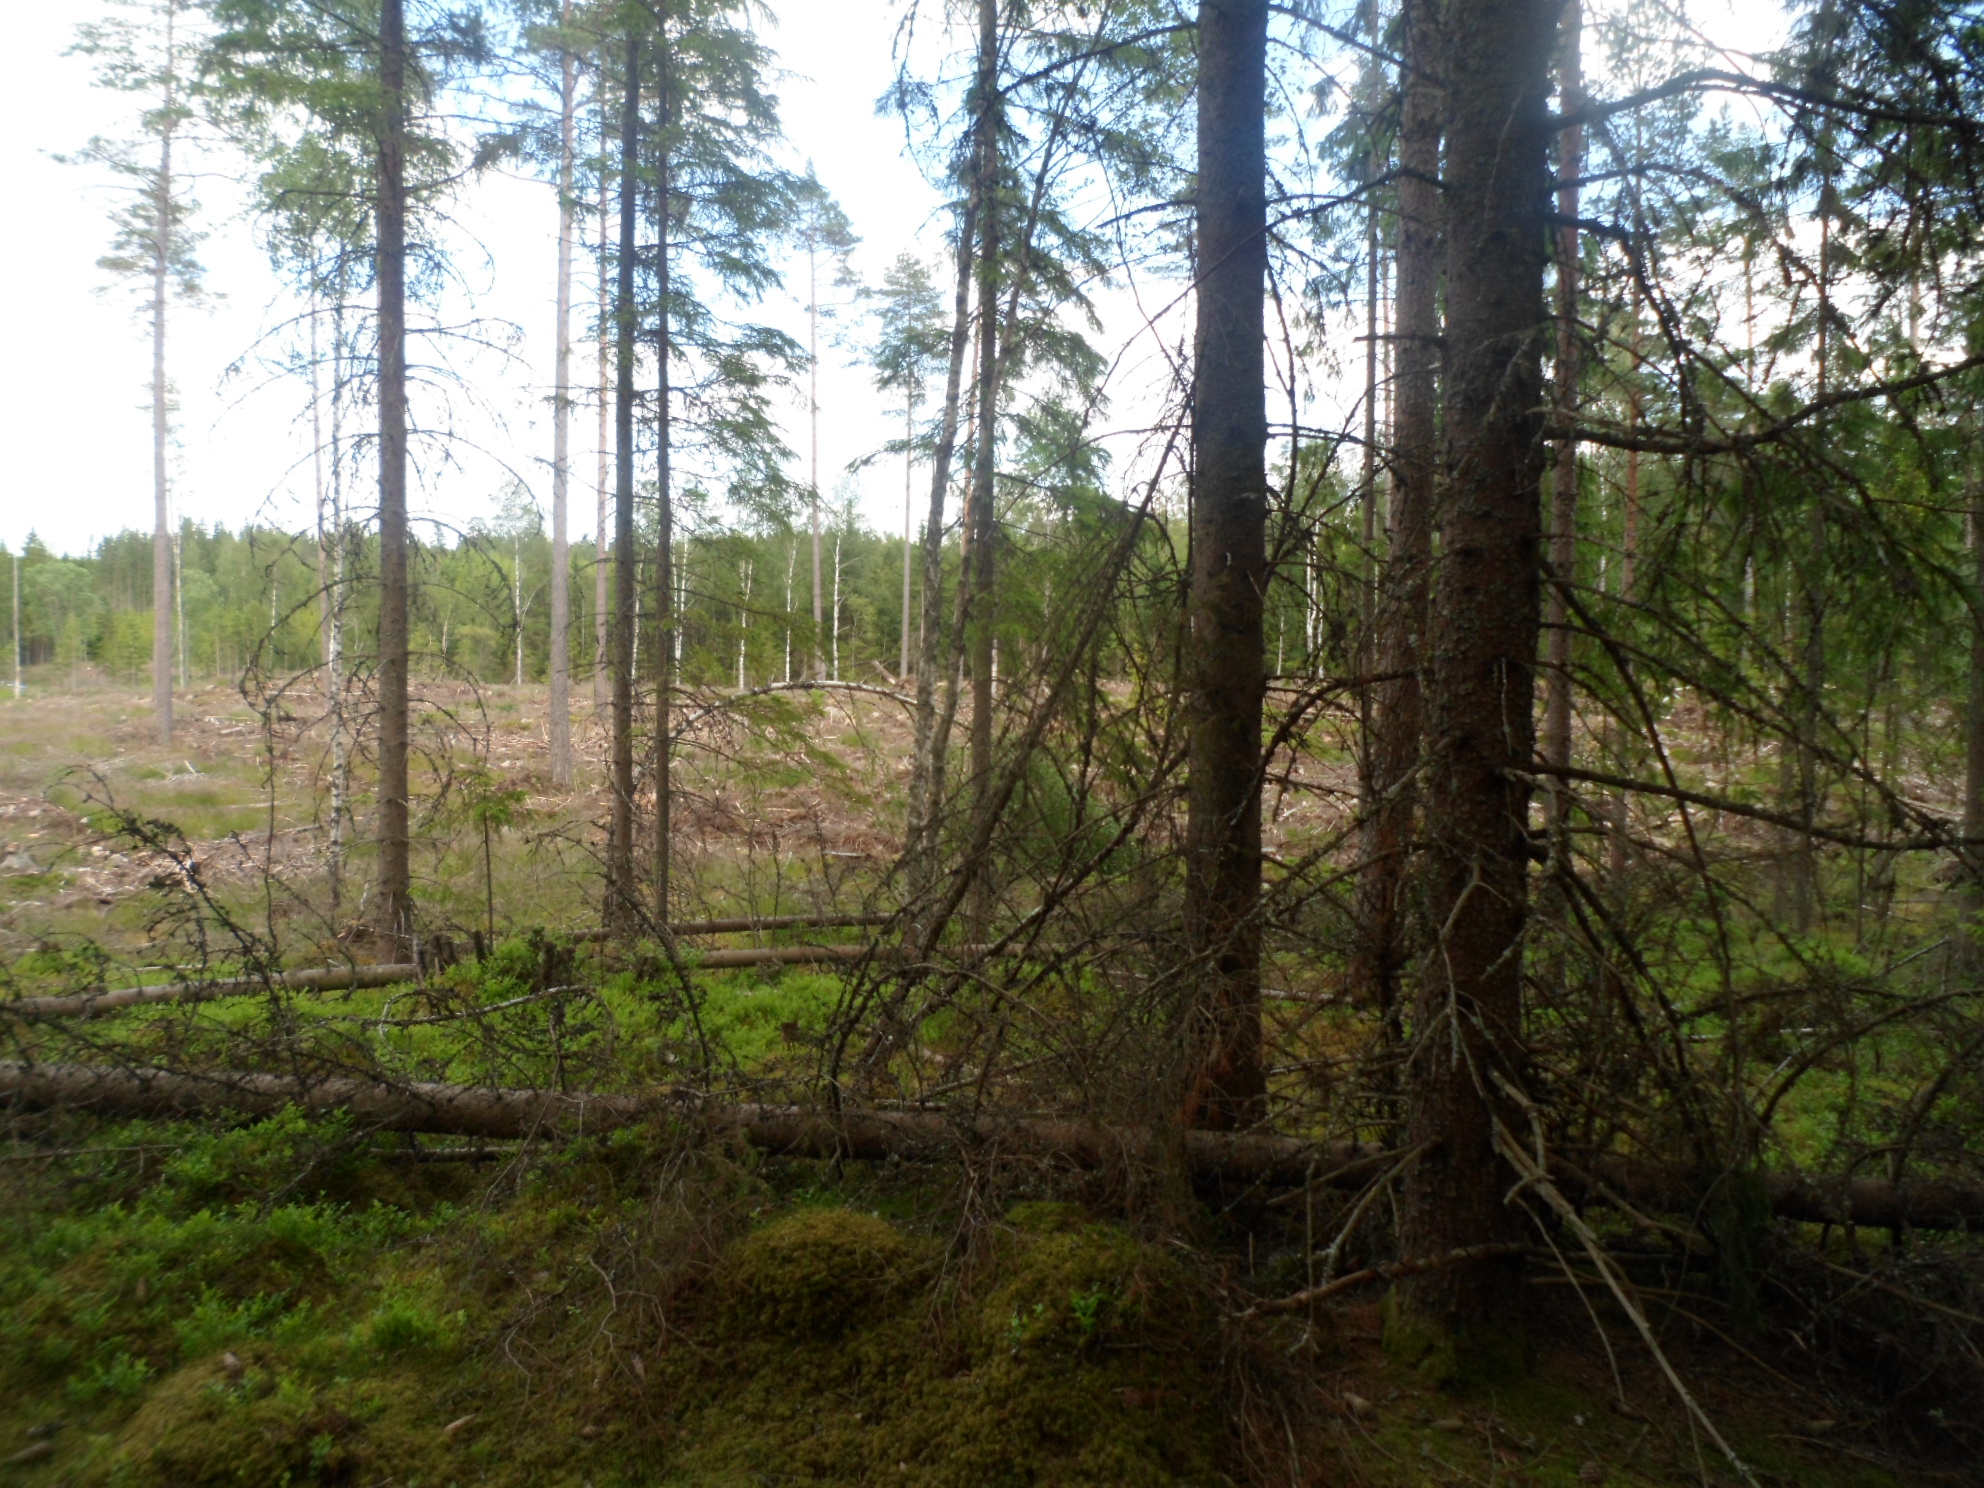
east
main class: Woodland
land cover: Spruce dominated coniferous woodland
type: boreal forest
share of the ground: 50 - 75 %
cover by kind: coniferous forest trees 60 %, shrubs 15 %, lichens and mosses 15 %, broadleaved forest trees 5 %, herbaceous plants 5 %
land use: Forestry
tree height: > 5 m
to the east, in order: Spruce dominated coniferous woodland; Shrubland with sparse tree cover; Ditches and canals; Spruce dominated coniferous woodland; Ditches and canals; Groves; Fences; Grassland without tree/shrub cover; Grassland with sparse tree/shrub cover; Broadleaved woodland; Electric lines; Broadleaved woodland; Fences; Paved roads, cycling and walking lanes; Fences; Grassland without tree/shrub cover; Grassland with sparse tree/shrub cover
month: July
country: SE
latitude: 57.5354
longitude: 14.3885
